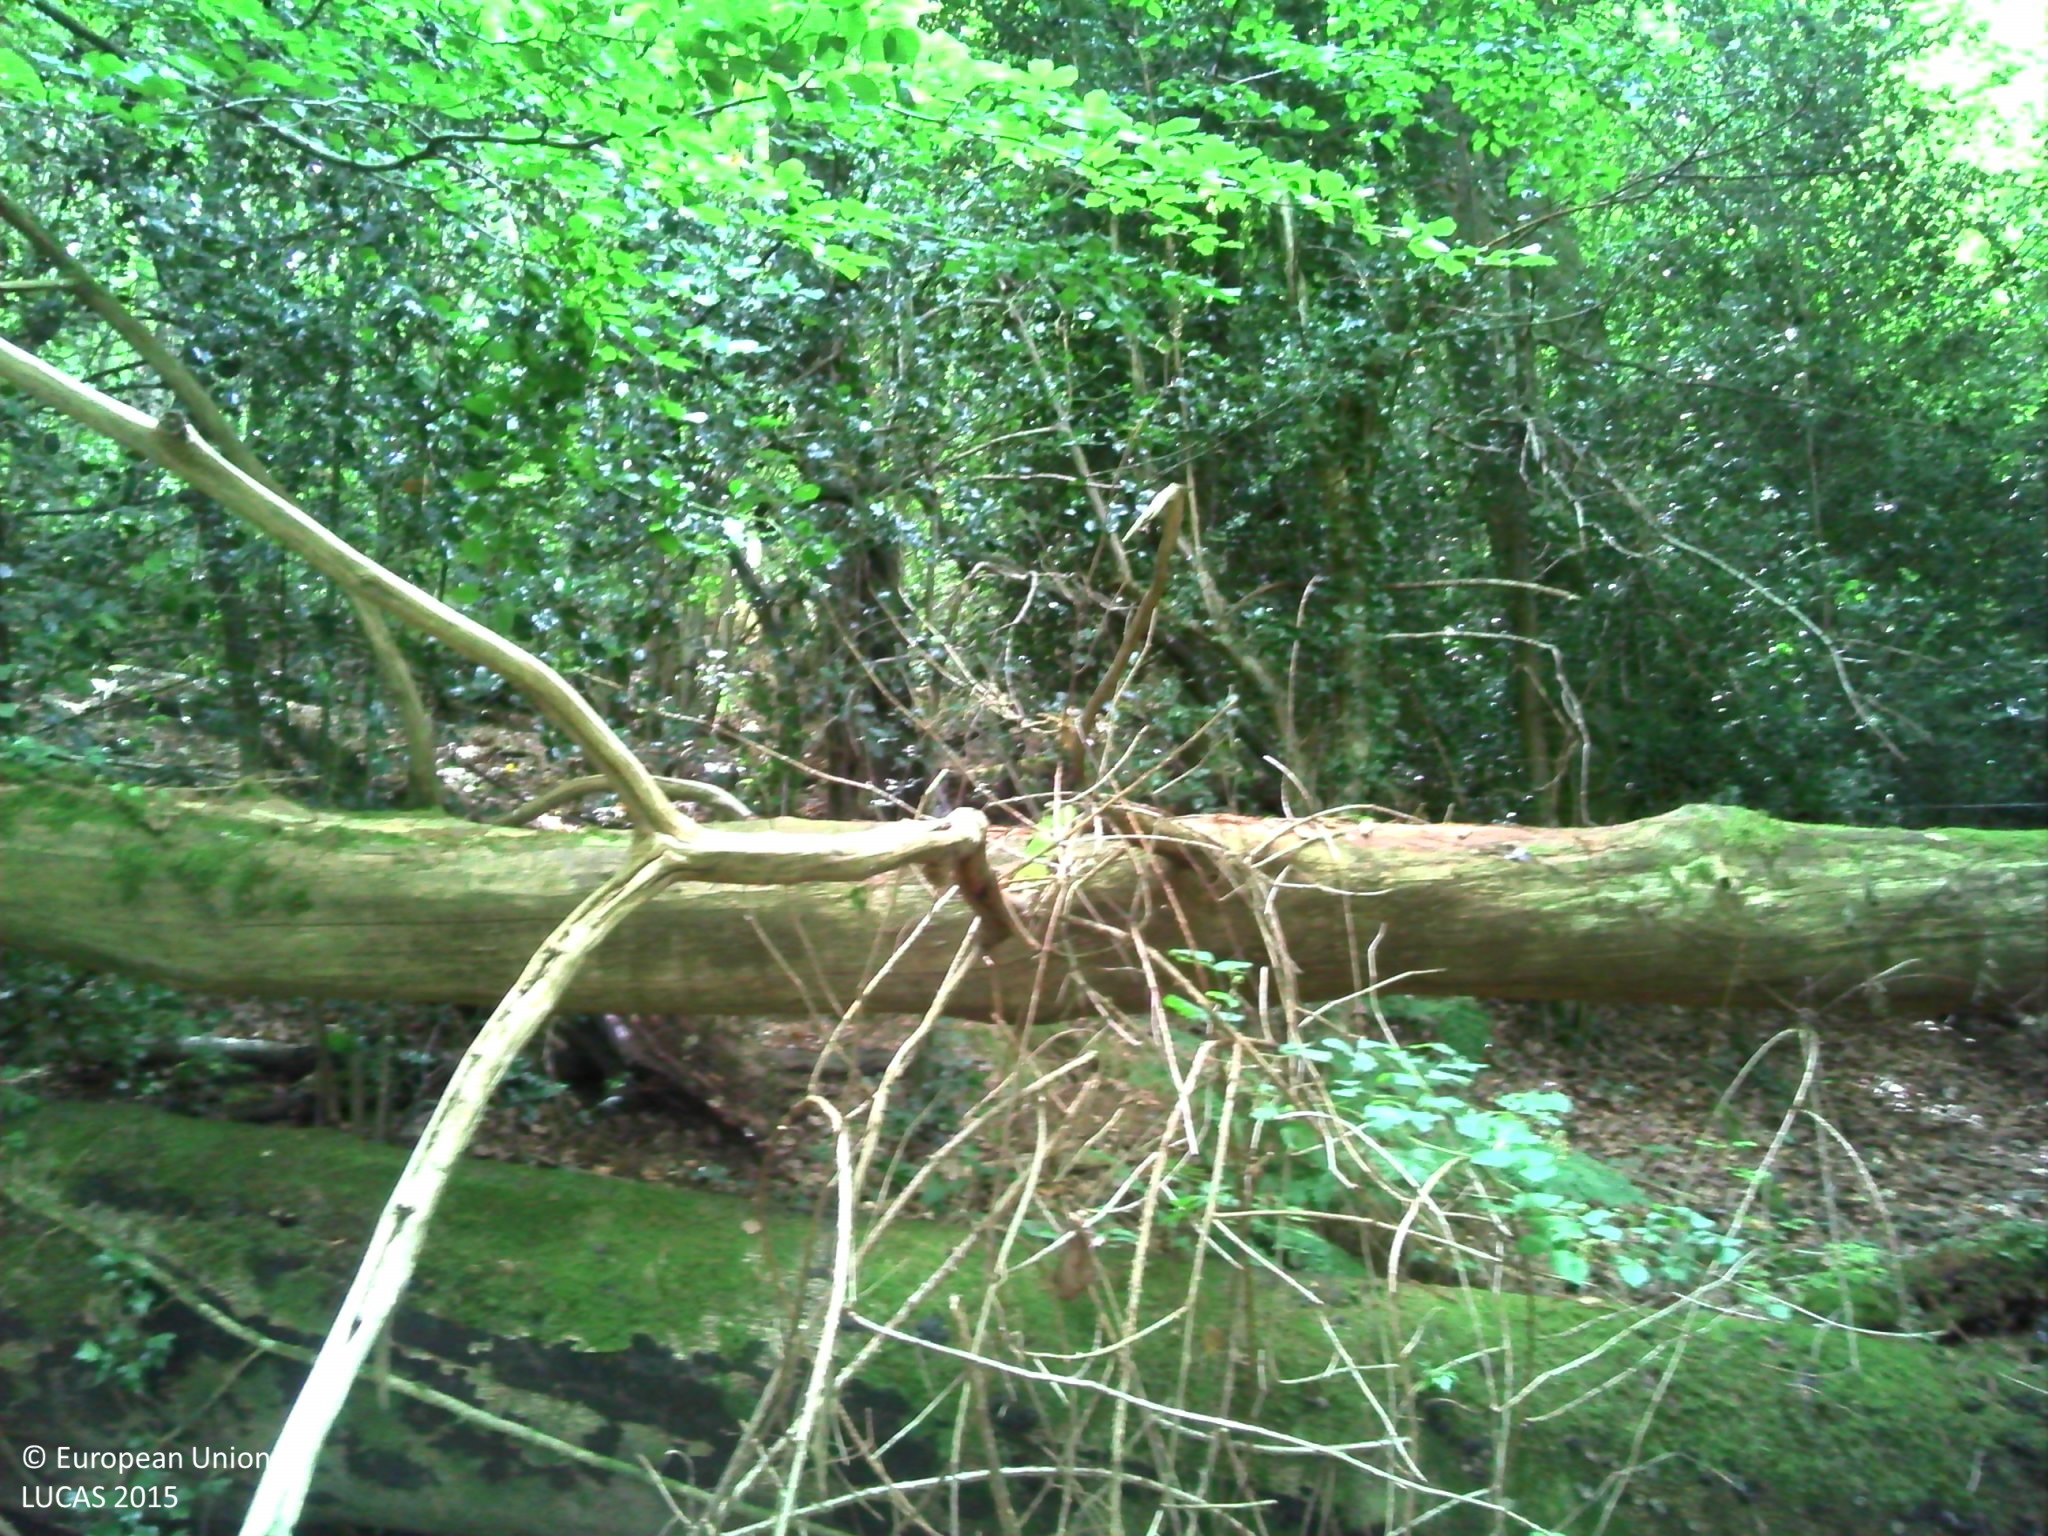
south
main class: Woodland
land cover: Broadleaved woodland
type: beech forest
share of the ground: > 75 %
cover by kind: broadleaved forest trees 95 %, shrubs 5 %
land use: Forestry
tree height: > 5 m
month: August
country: FR
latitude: 48.6961
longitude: -1.2806
